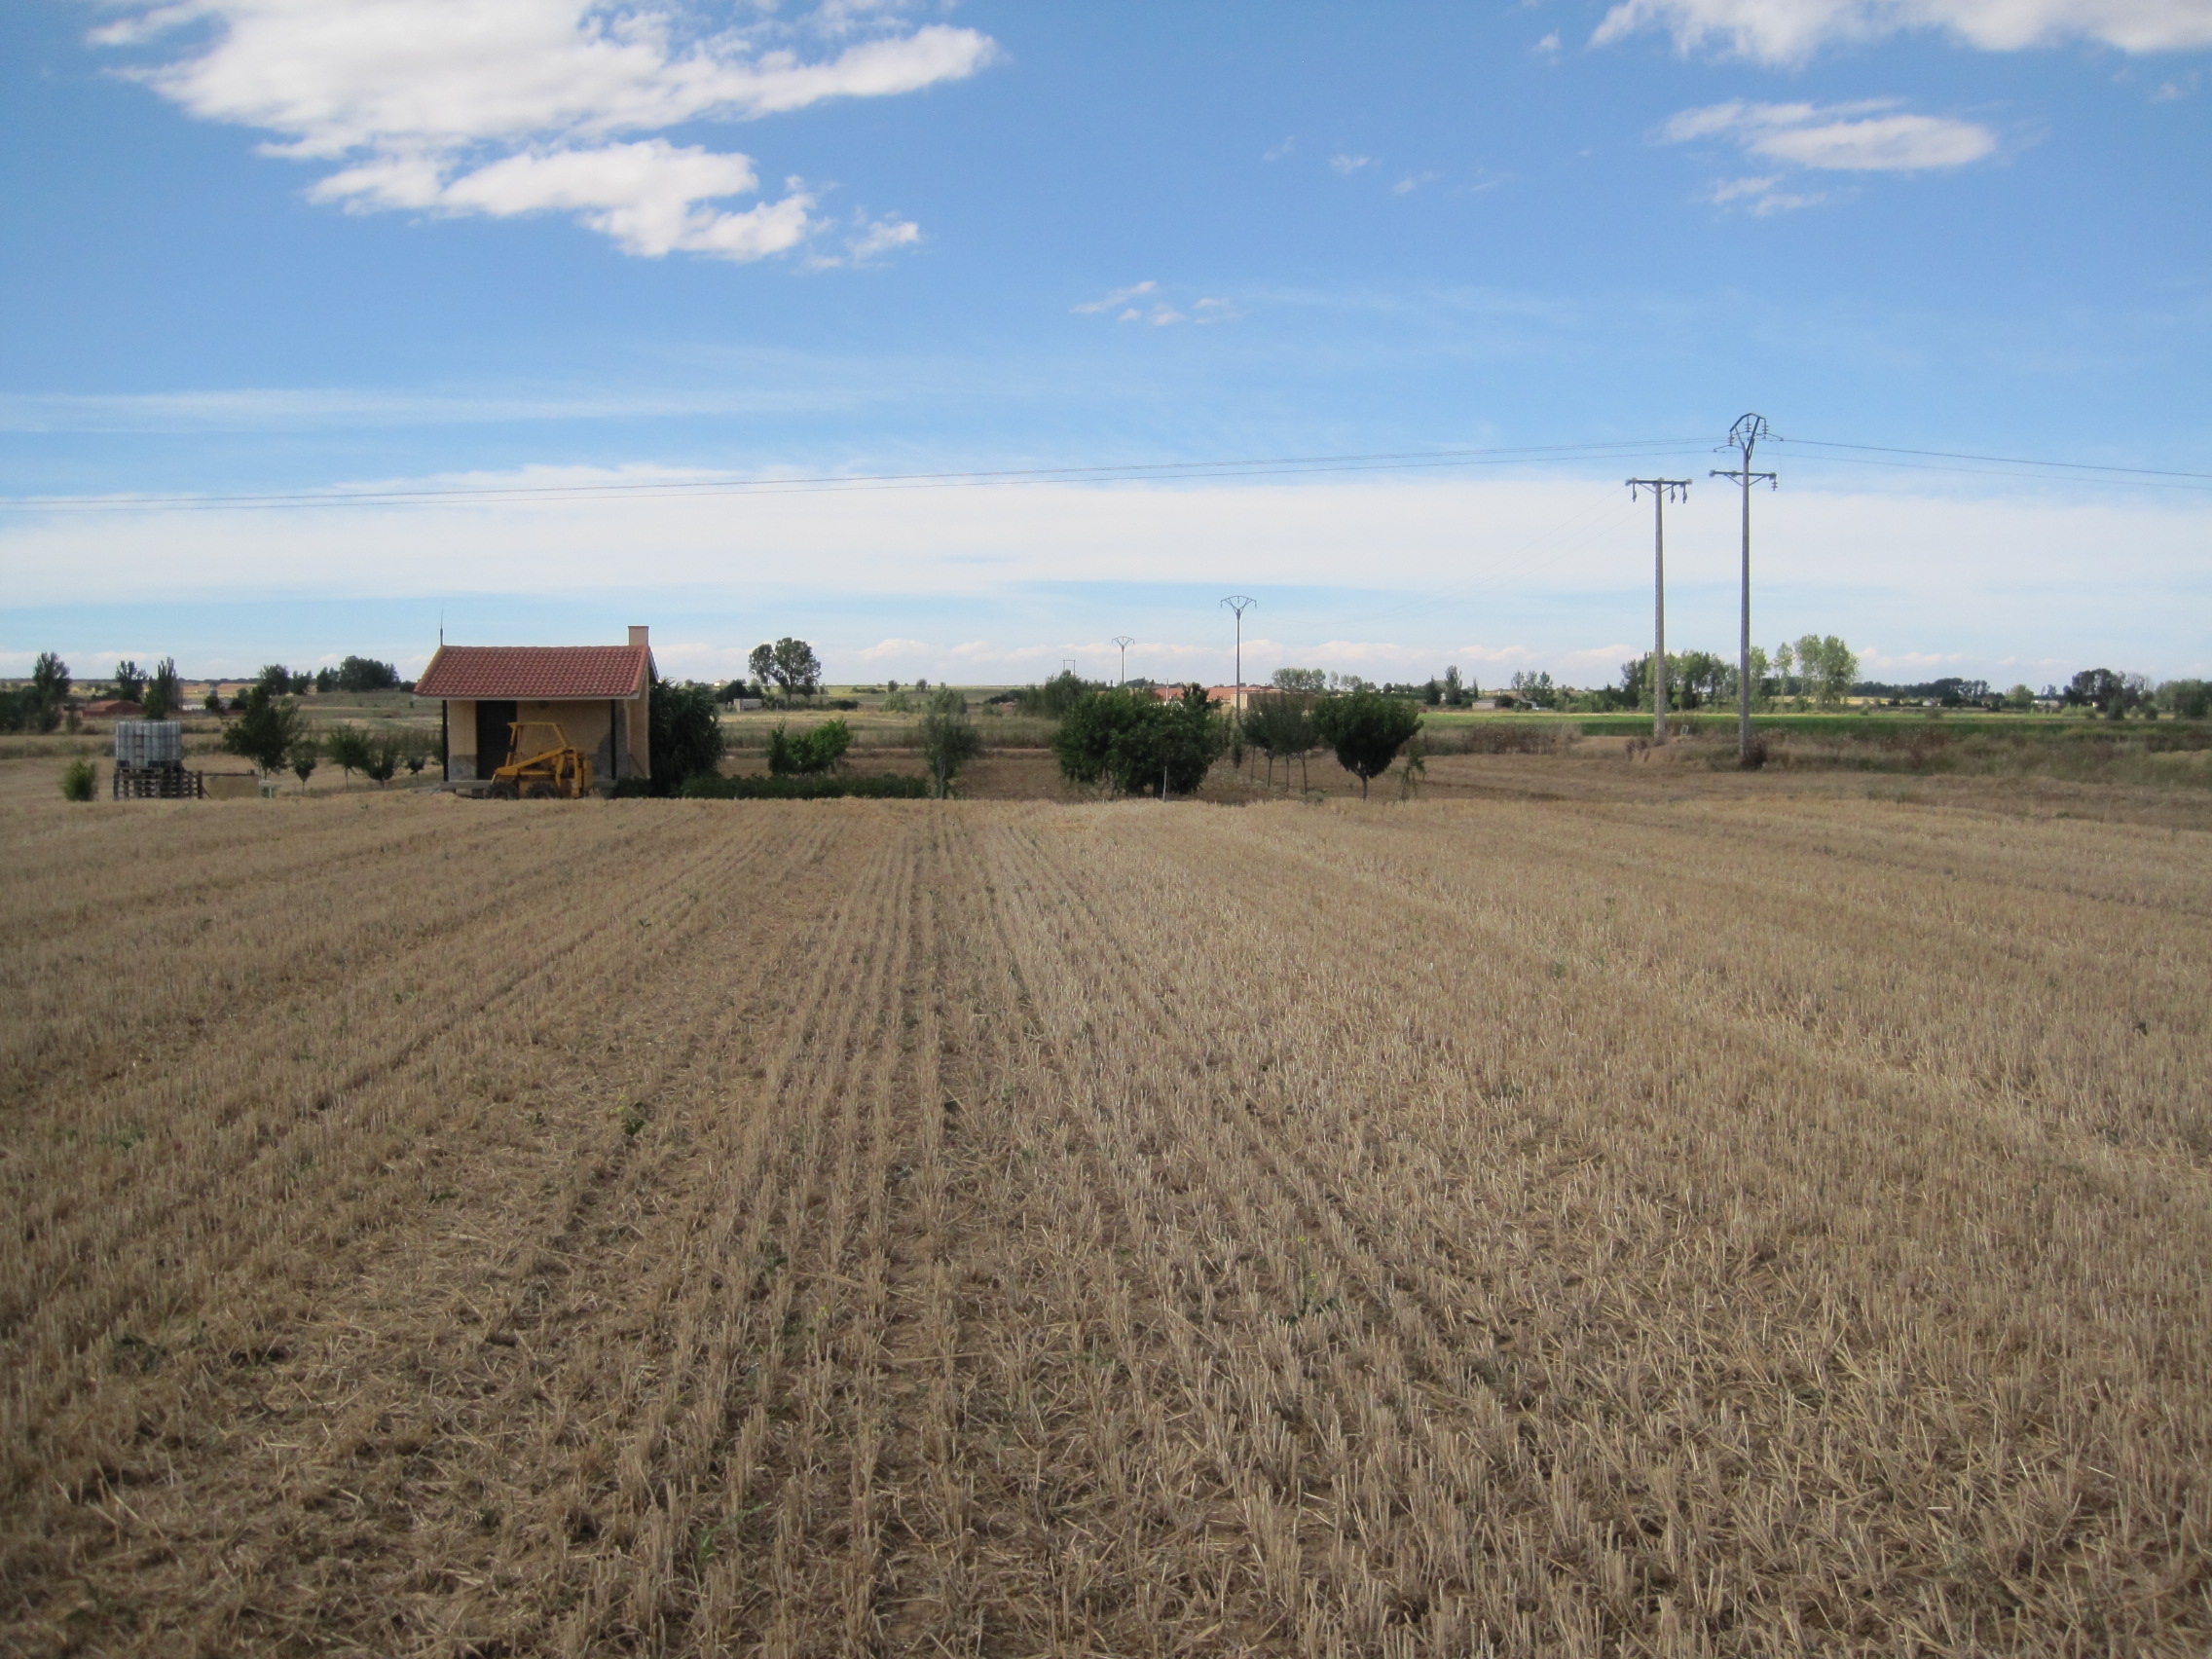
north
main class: Cropland
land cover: Common wheat
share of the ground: < 10 %
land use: Agriculture (excluding fallow land and kitchen gardens)
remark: Harvested field
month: July
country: ES
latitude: 42.0838
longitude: -5.4530
